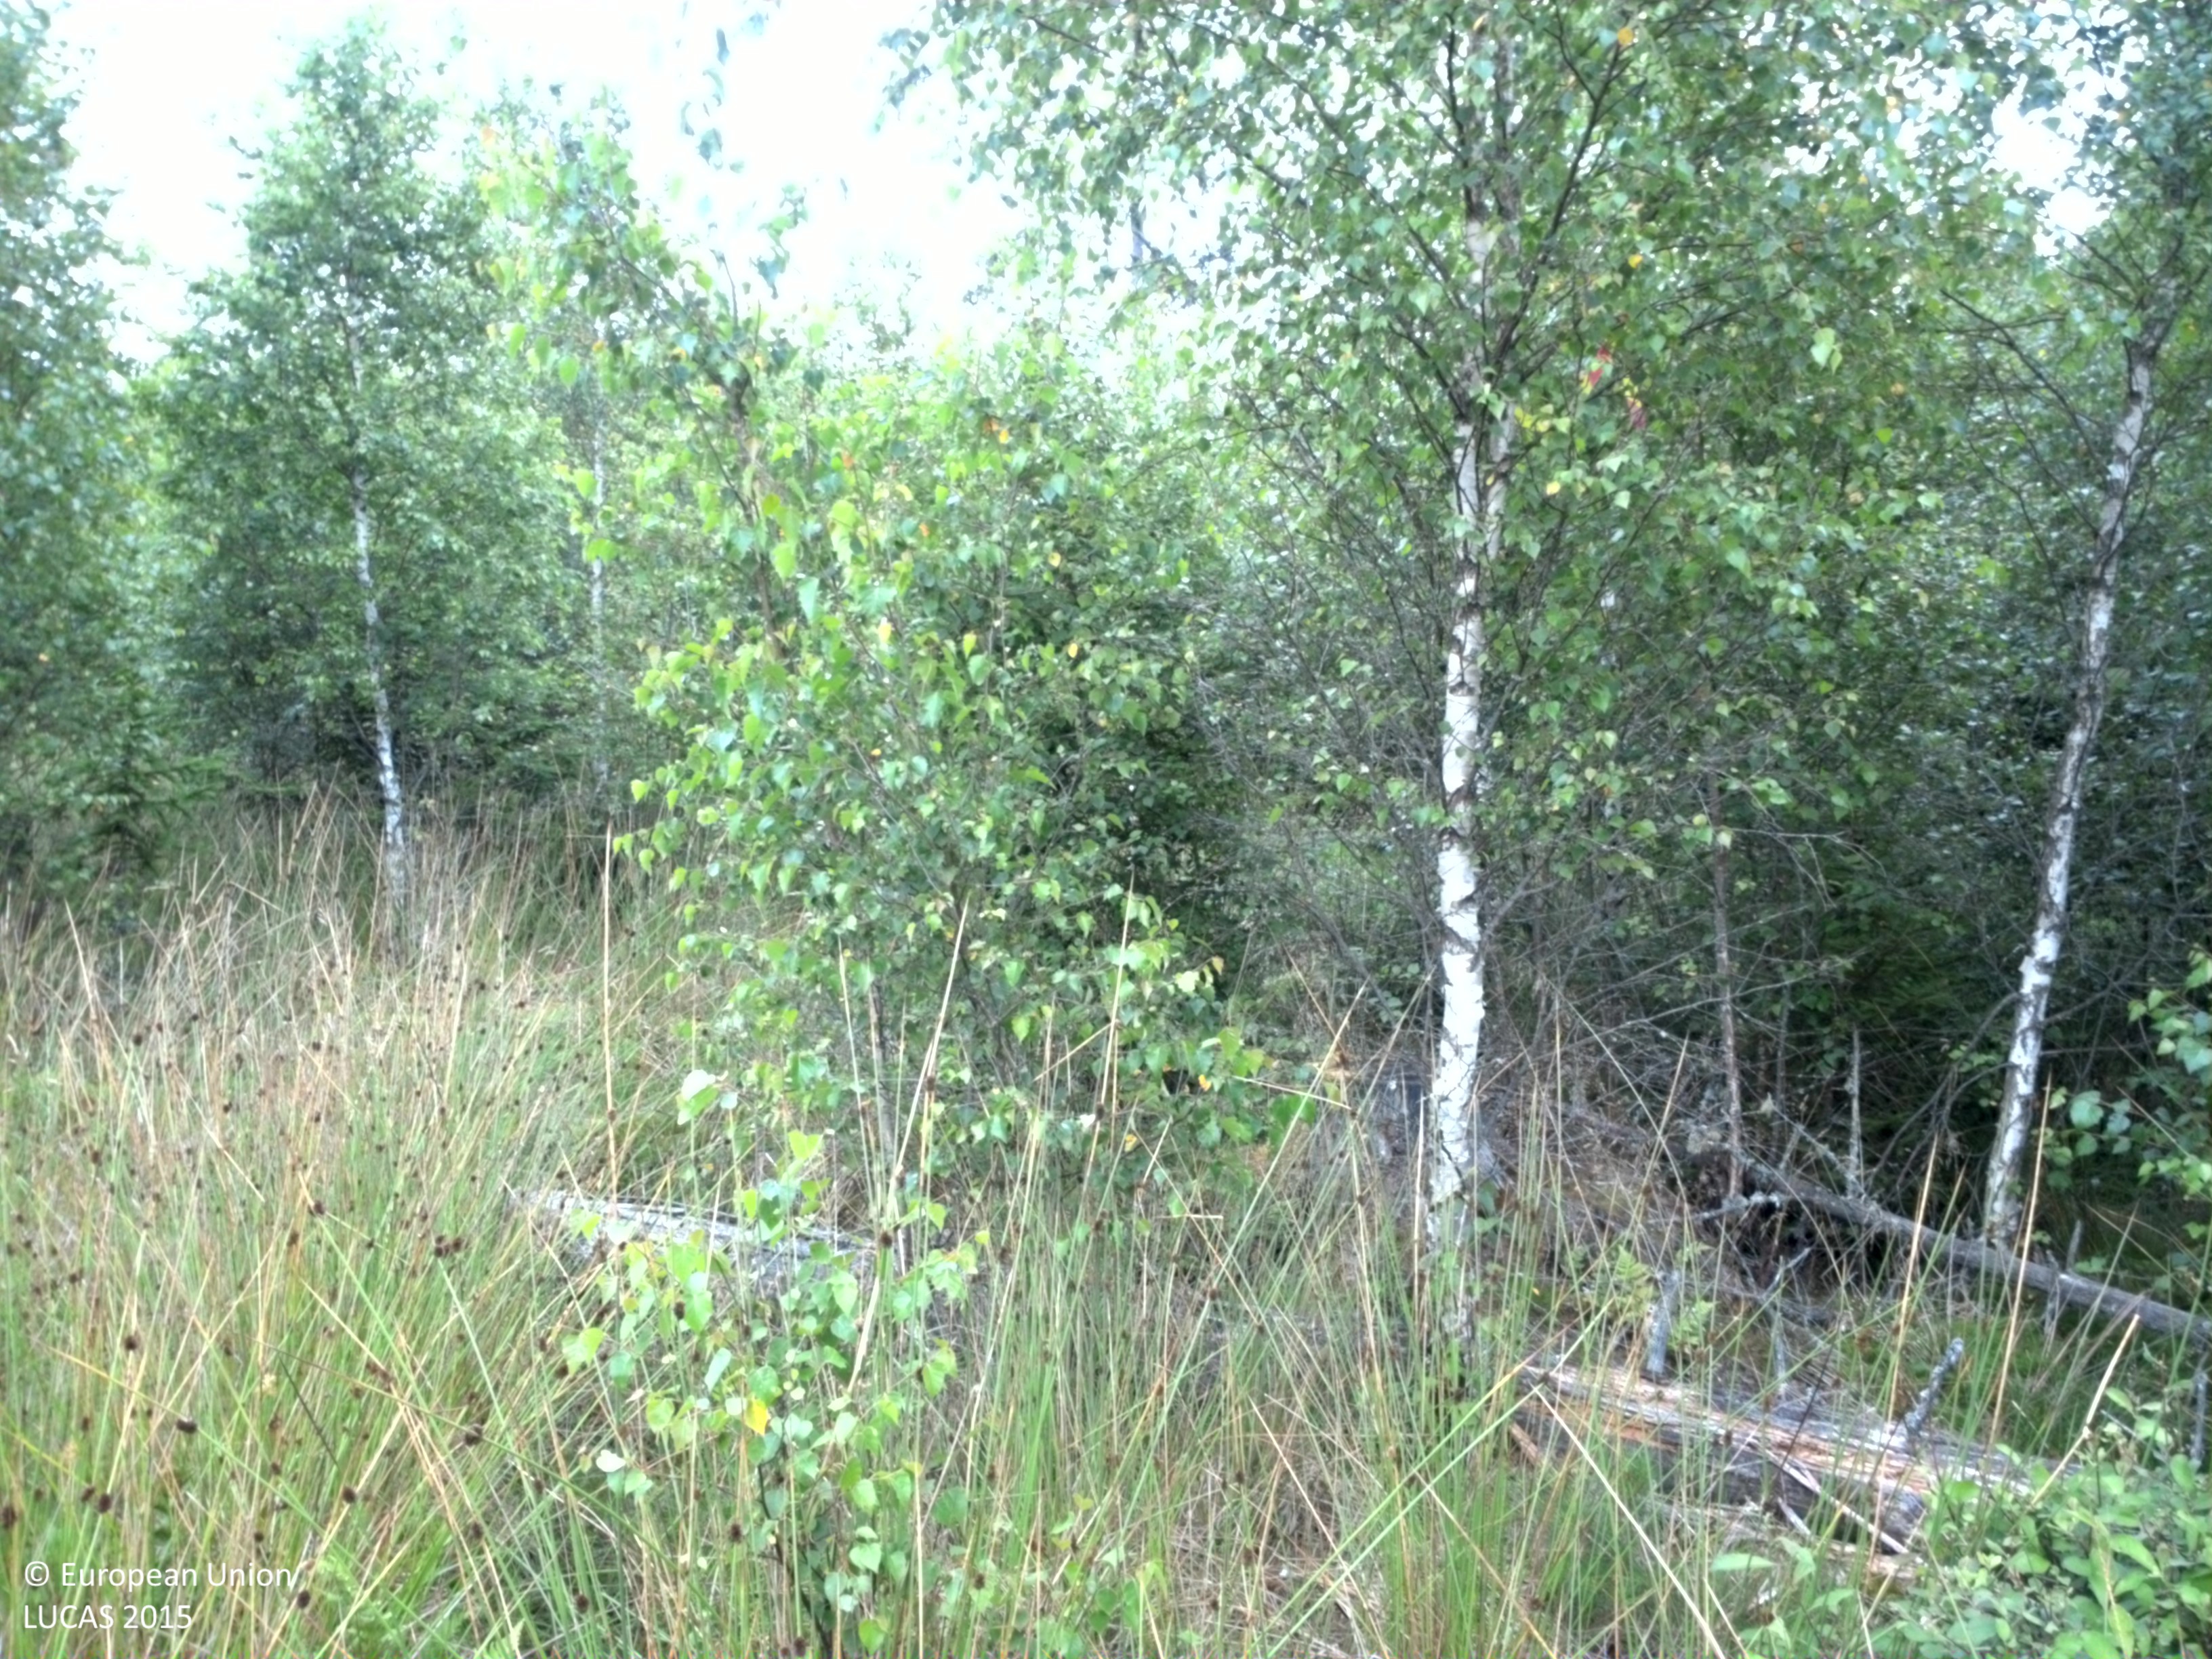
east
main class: Grassland
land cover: Grassland with sparse tree/shrub cover
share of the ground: > 75 %
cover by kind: herbaceous plants 90 %, broadleaved forest trees 5 %, shrubs 5 %
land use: Forestry
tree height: < 5 m
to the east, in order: Grassland with sparse tree/shrub cover; Spruce dominated mixed woodland; Pine dominated mixed woodland; Tracks; Pine dominated mixed woodland; Pine dominated coniferous woodland
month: July
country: SE
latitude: 58.3396
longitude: 13.3593
